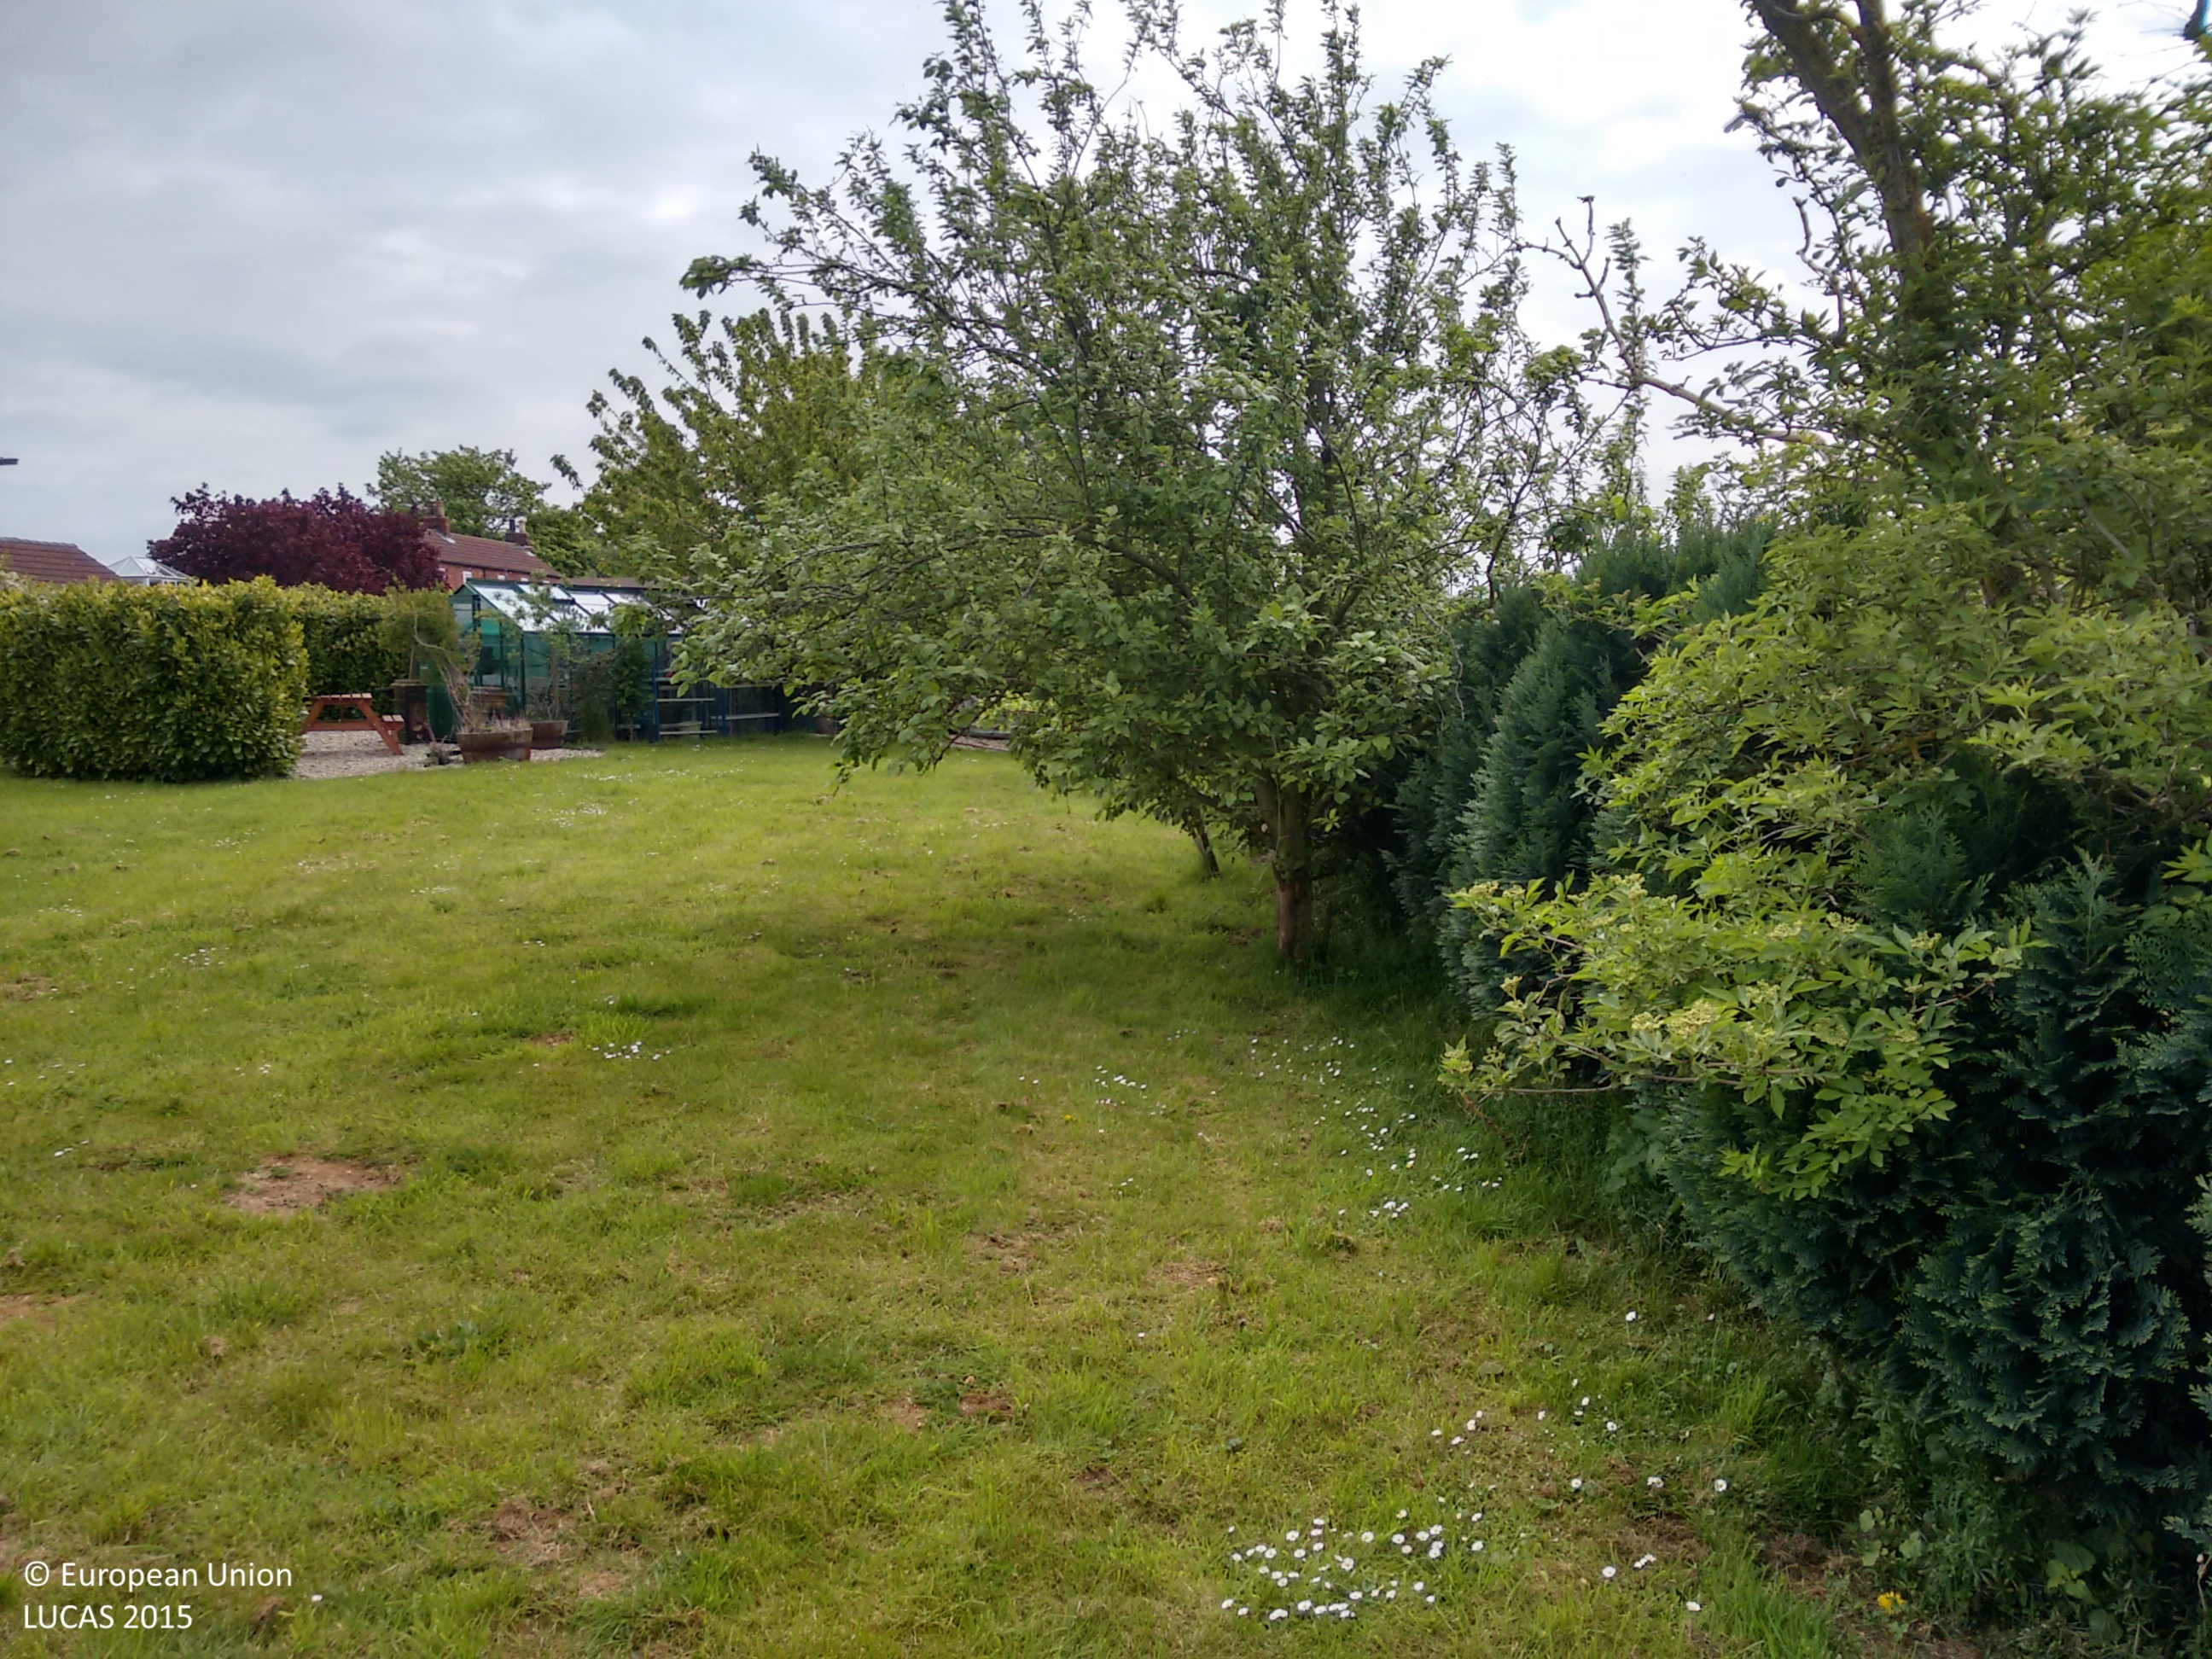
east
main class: Grassland
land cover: Grassland without tree/shrub cover
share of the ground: > 75 %
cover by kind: herbaceous plants 100 %
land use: Residential
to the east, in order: Grassland without tree/shrub cover; Artificial constructions in urban areas
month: May
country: GB
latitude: 53.5753
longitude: -0.7476
